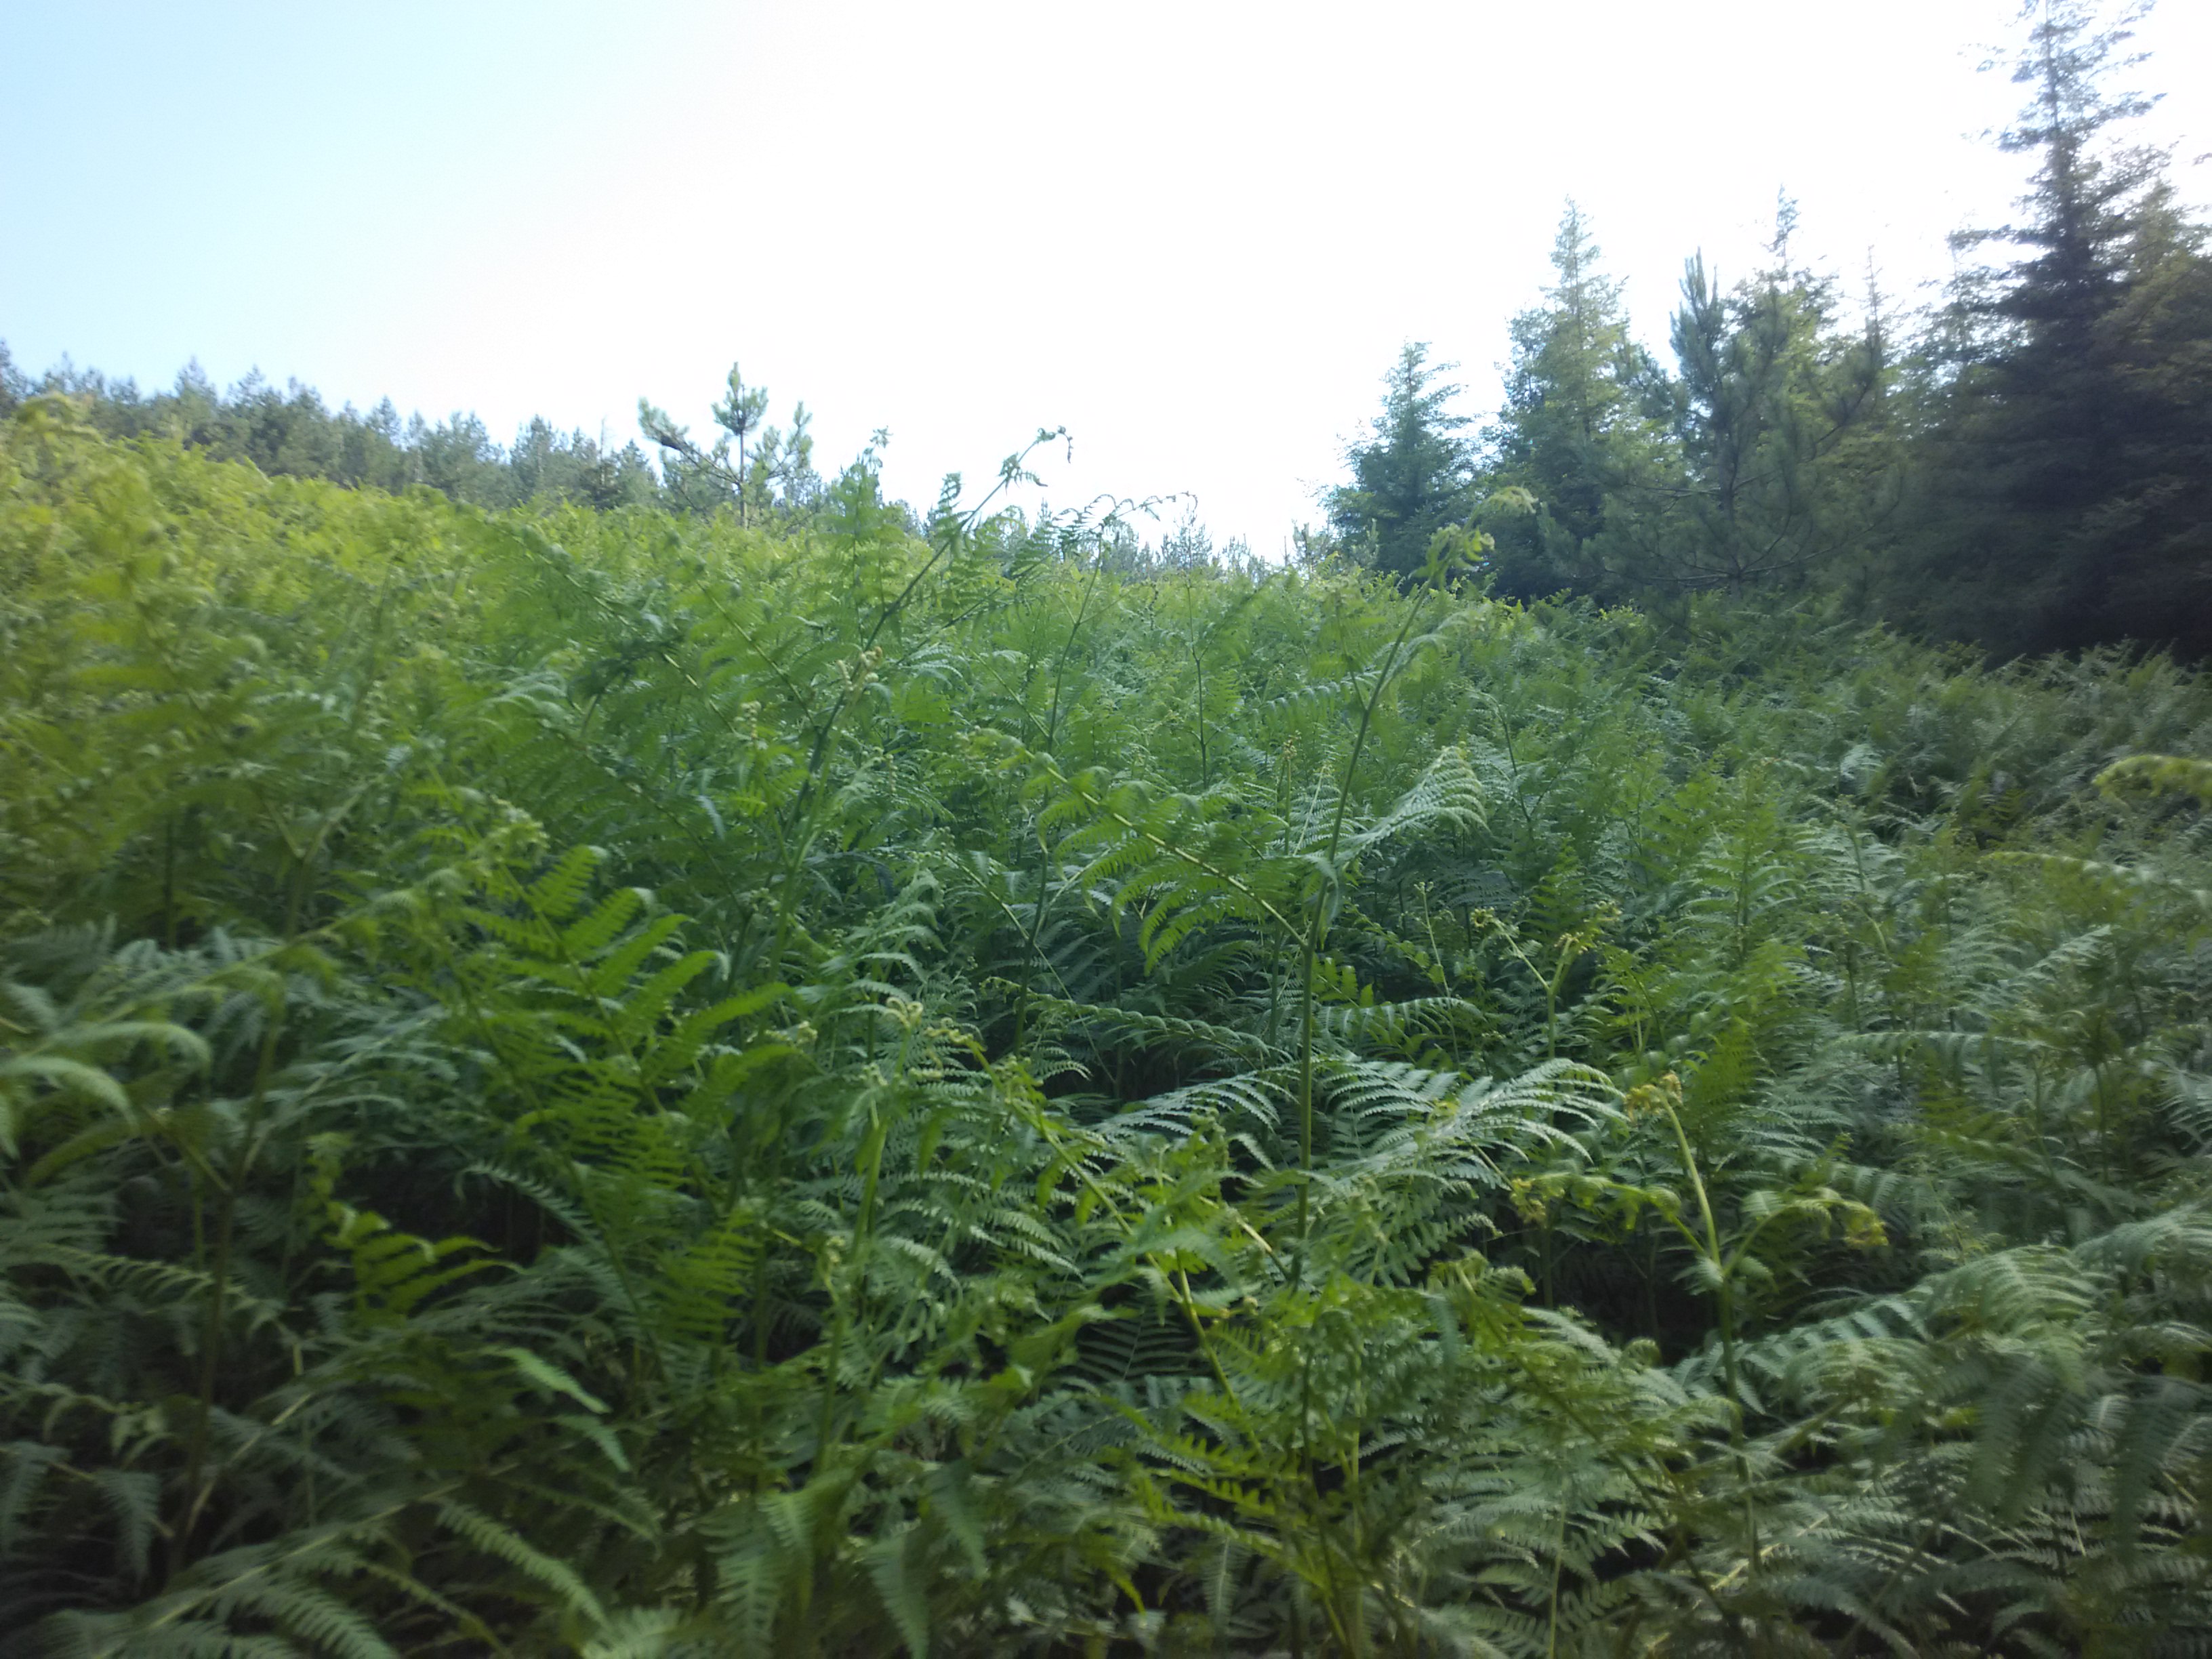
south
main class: Grassland
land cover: Grassland with sparse tree/shrub cover
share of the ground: > 75 %
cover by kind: herbaceous plants 95 %, coniferous forest trees 5 %
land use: Semi-natural and natural areas not in use
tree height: > 5 m
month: June
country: ES
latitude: 43.0312
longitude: -2.3092
